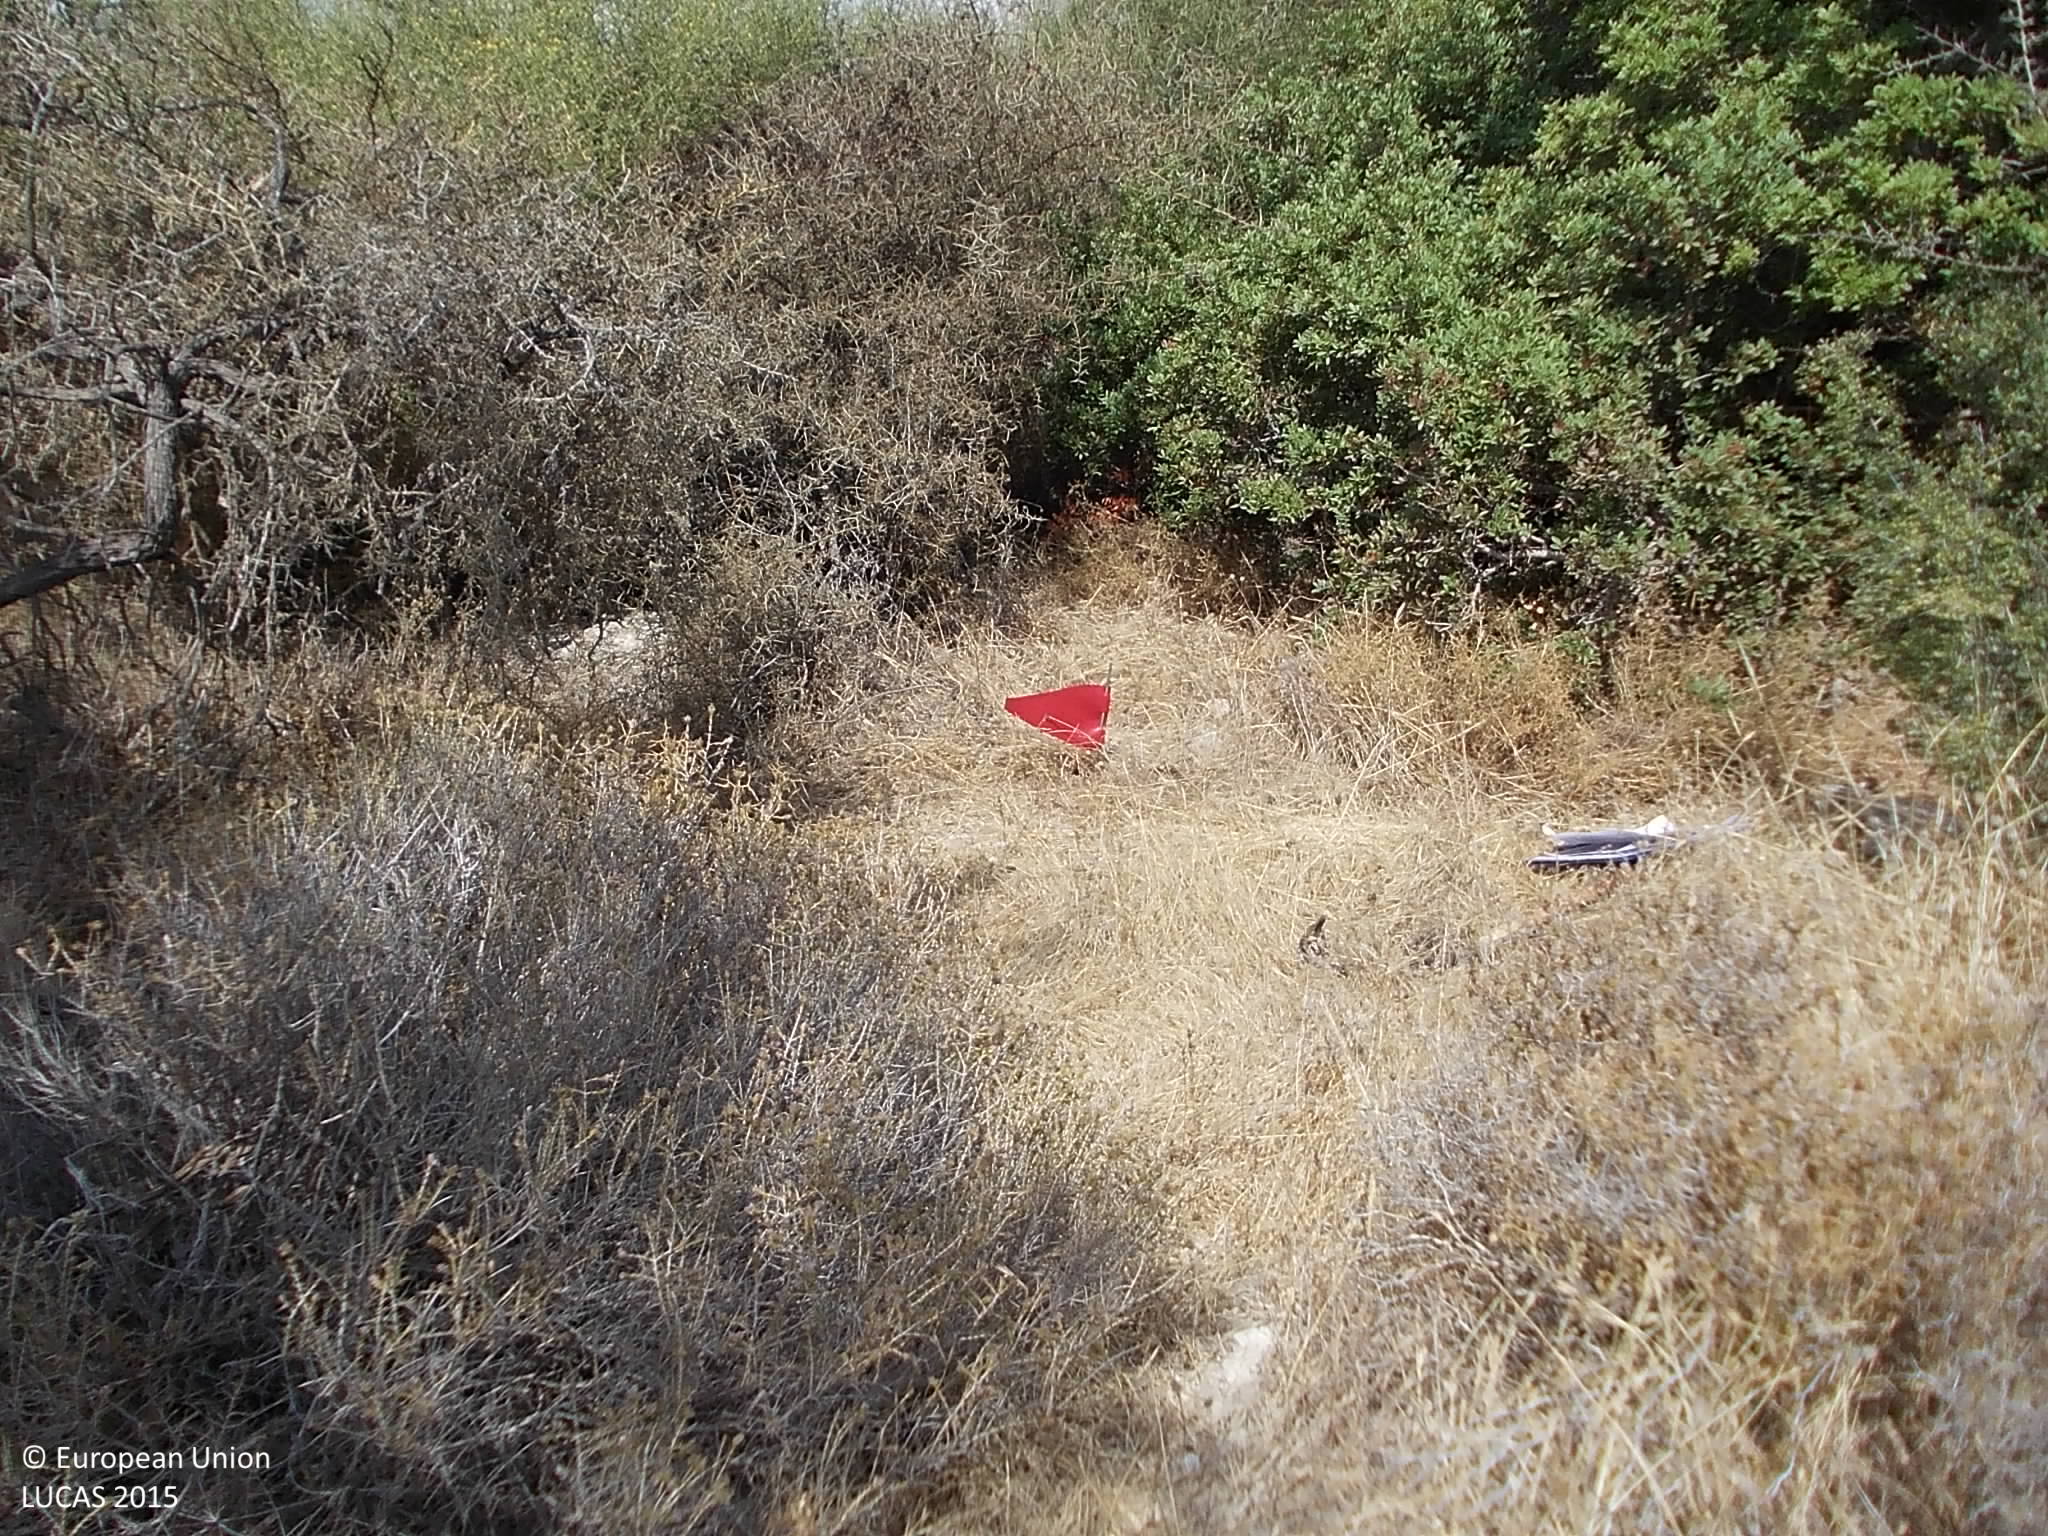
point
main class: Shrubland
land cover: Shrubland with sparse tree cover
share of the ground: > 75 %
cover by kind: shrubs 85 %, broadleaved forest trees 5 %, herbaceous plants 5 %, unconsolidated bare surface 5 %
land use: Semi-natural and natural areas not in use
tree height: < 5 m
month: August
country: CY
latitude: 34.7023
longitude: 32.6967
